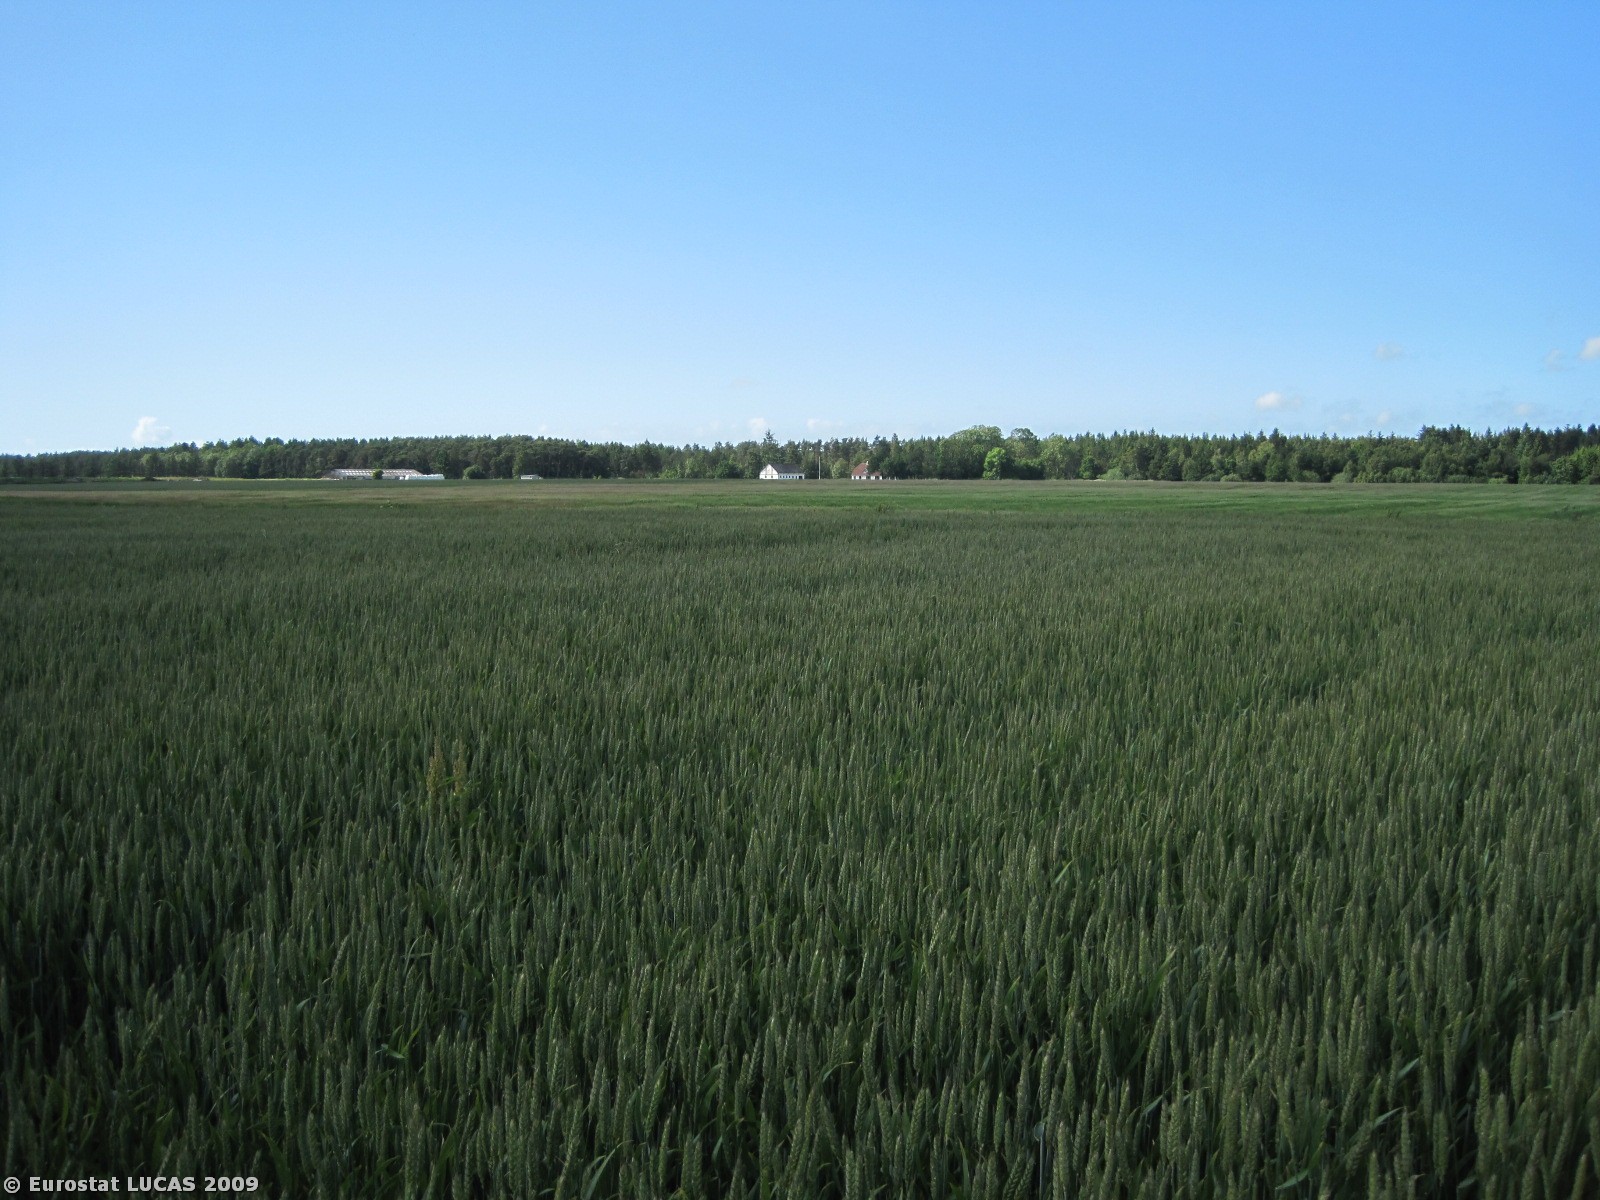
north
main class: Cropland
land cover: Common wheat
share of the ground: > 75 %
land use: Agriculture (excluding fallow land and kitchen gardens)
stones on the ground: < 10 %
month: June
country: DK
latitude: 57.1581
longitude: 9.6864
